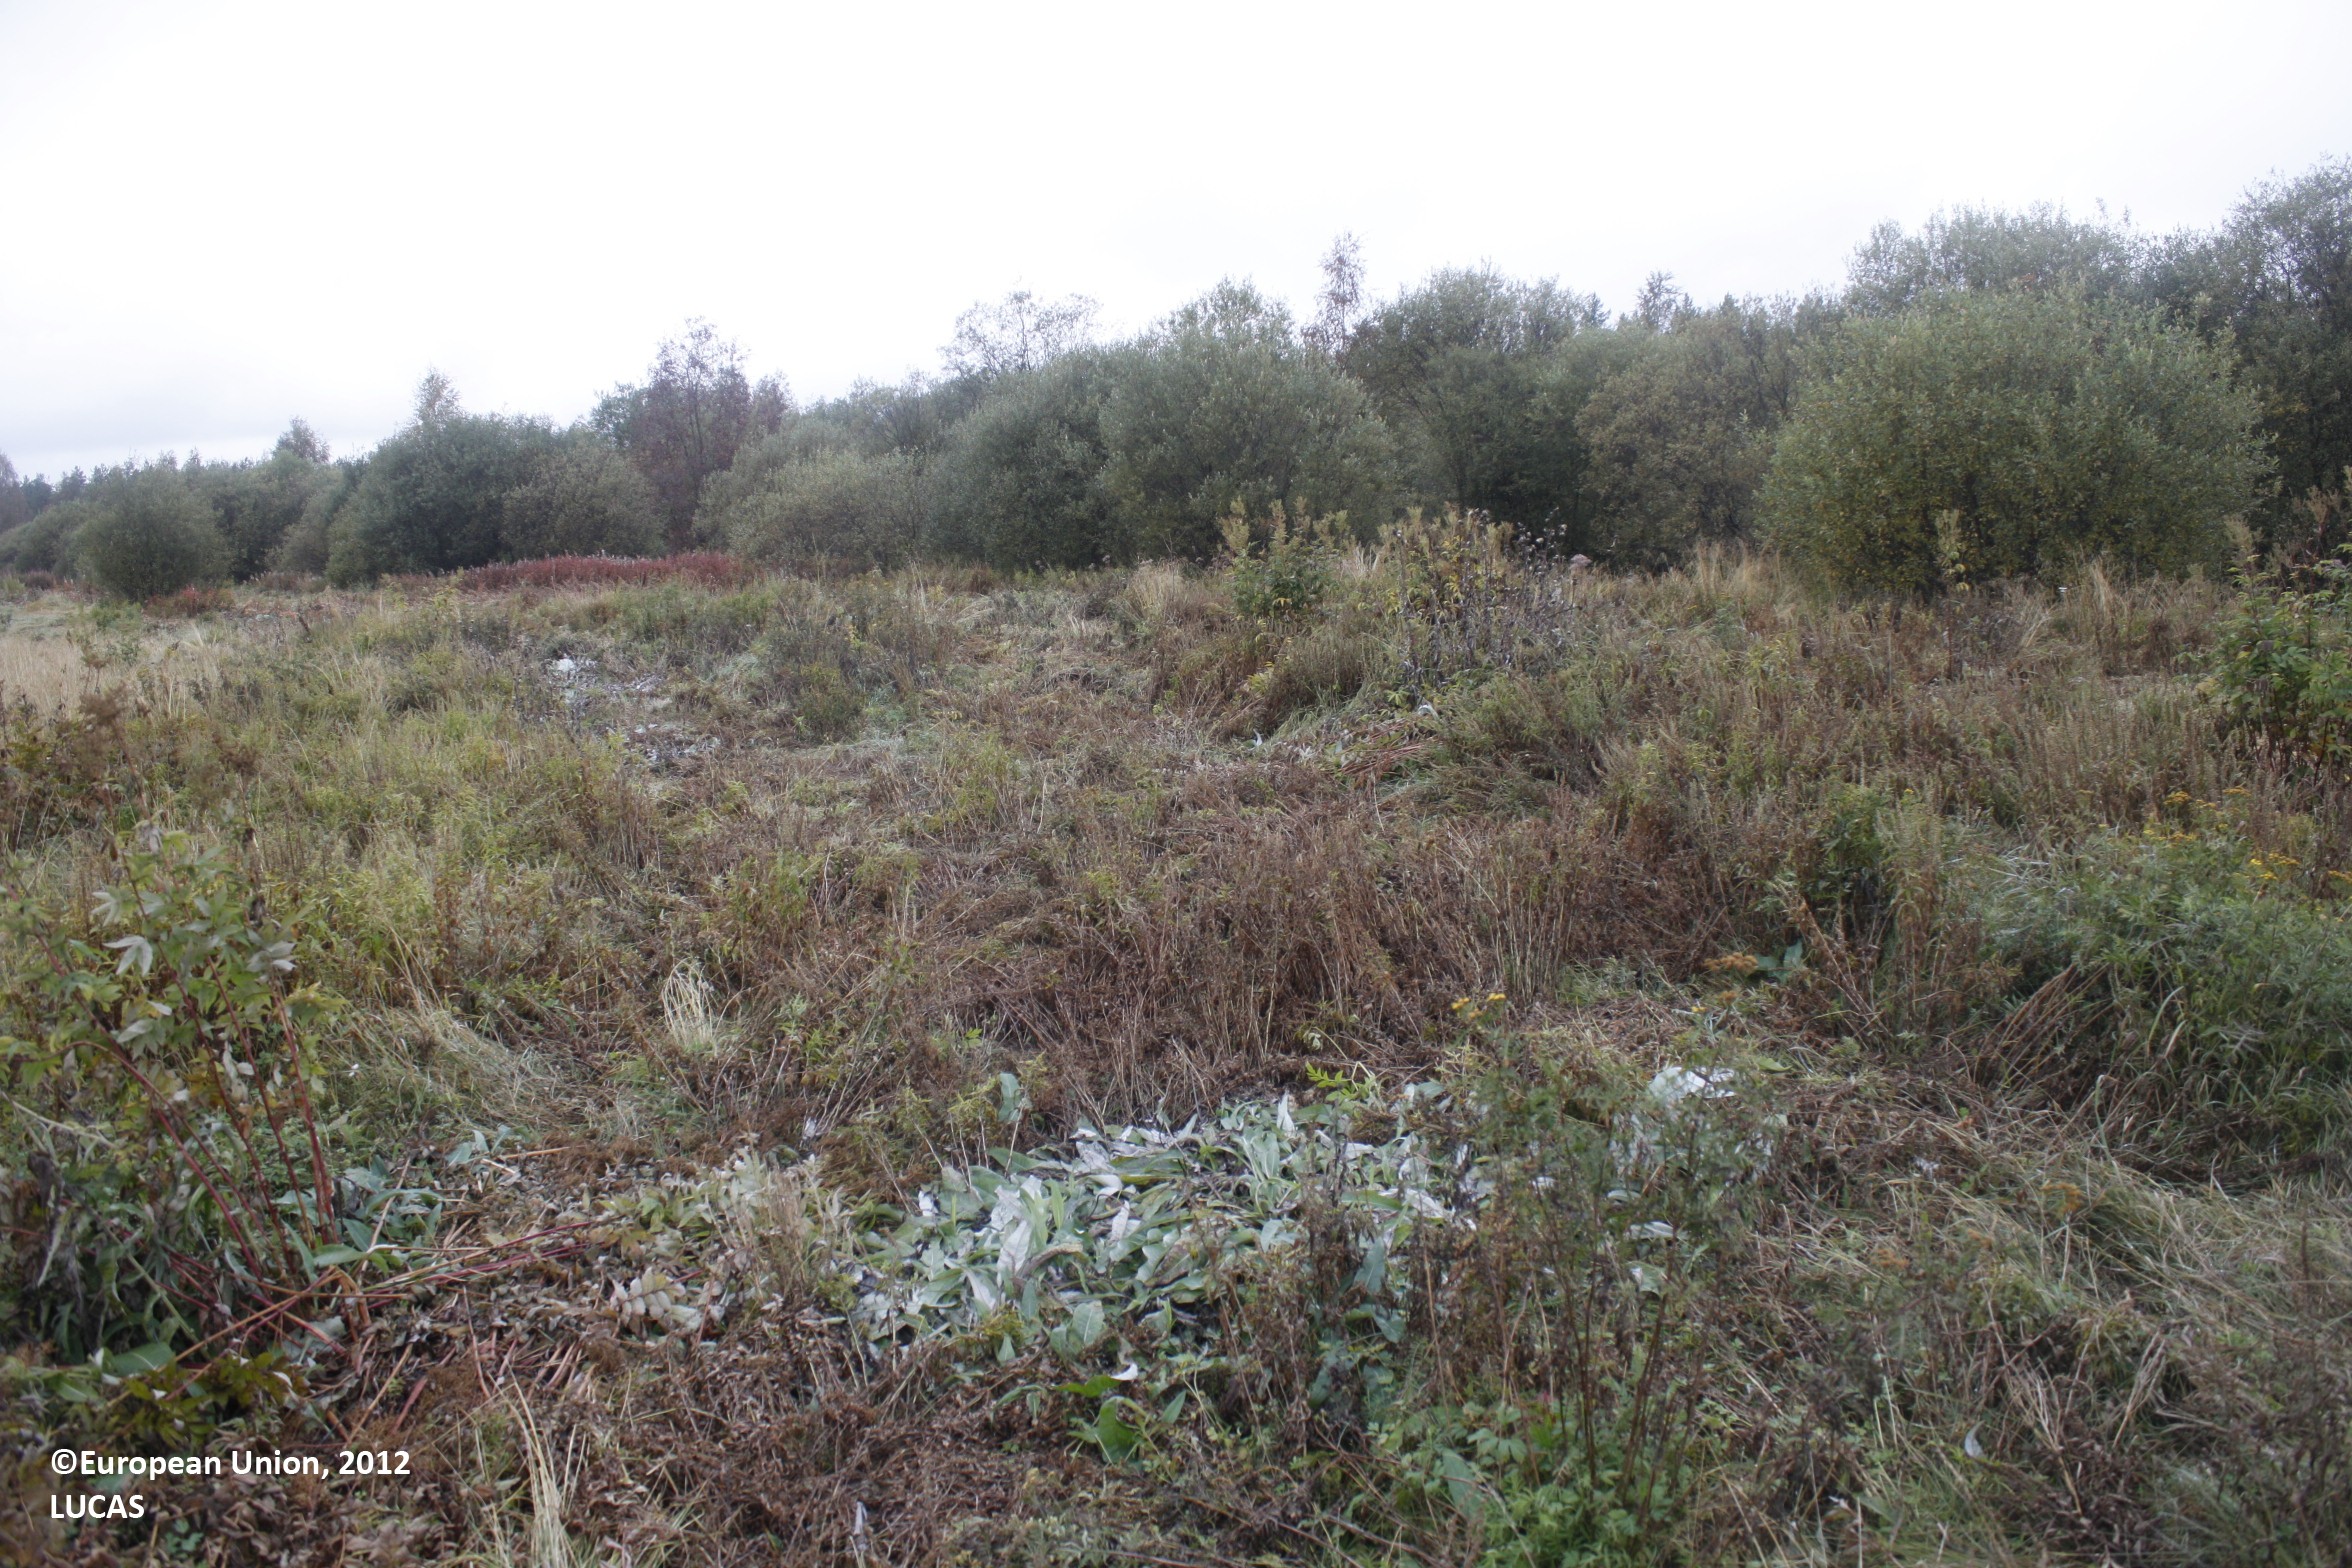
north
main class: Grassland
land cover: Spontaneously vegetated surfaces
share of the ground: > 75 %
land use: Fallow land
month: September
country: FI
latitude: 65.2096
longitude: 26.7189
